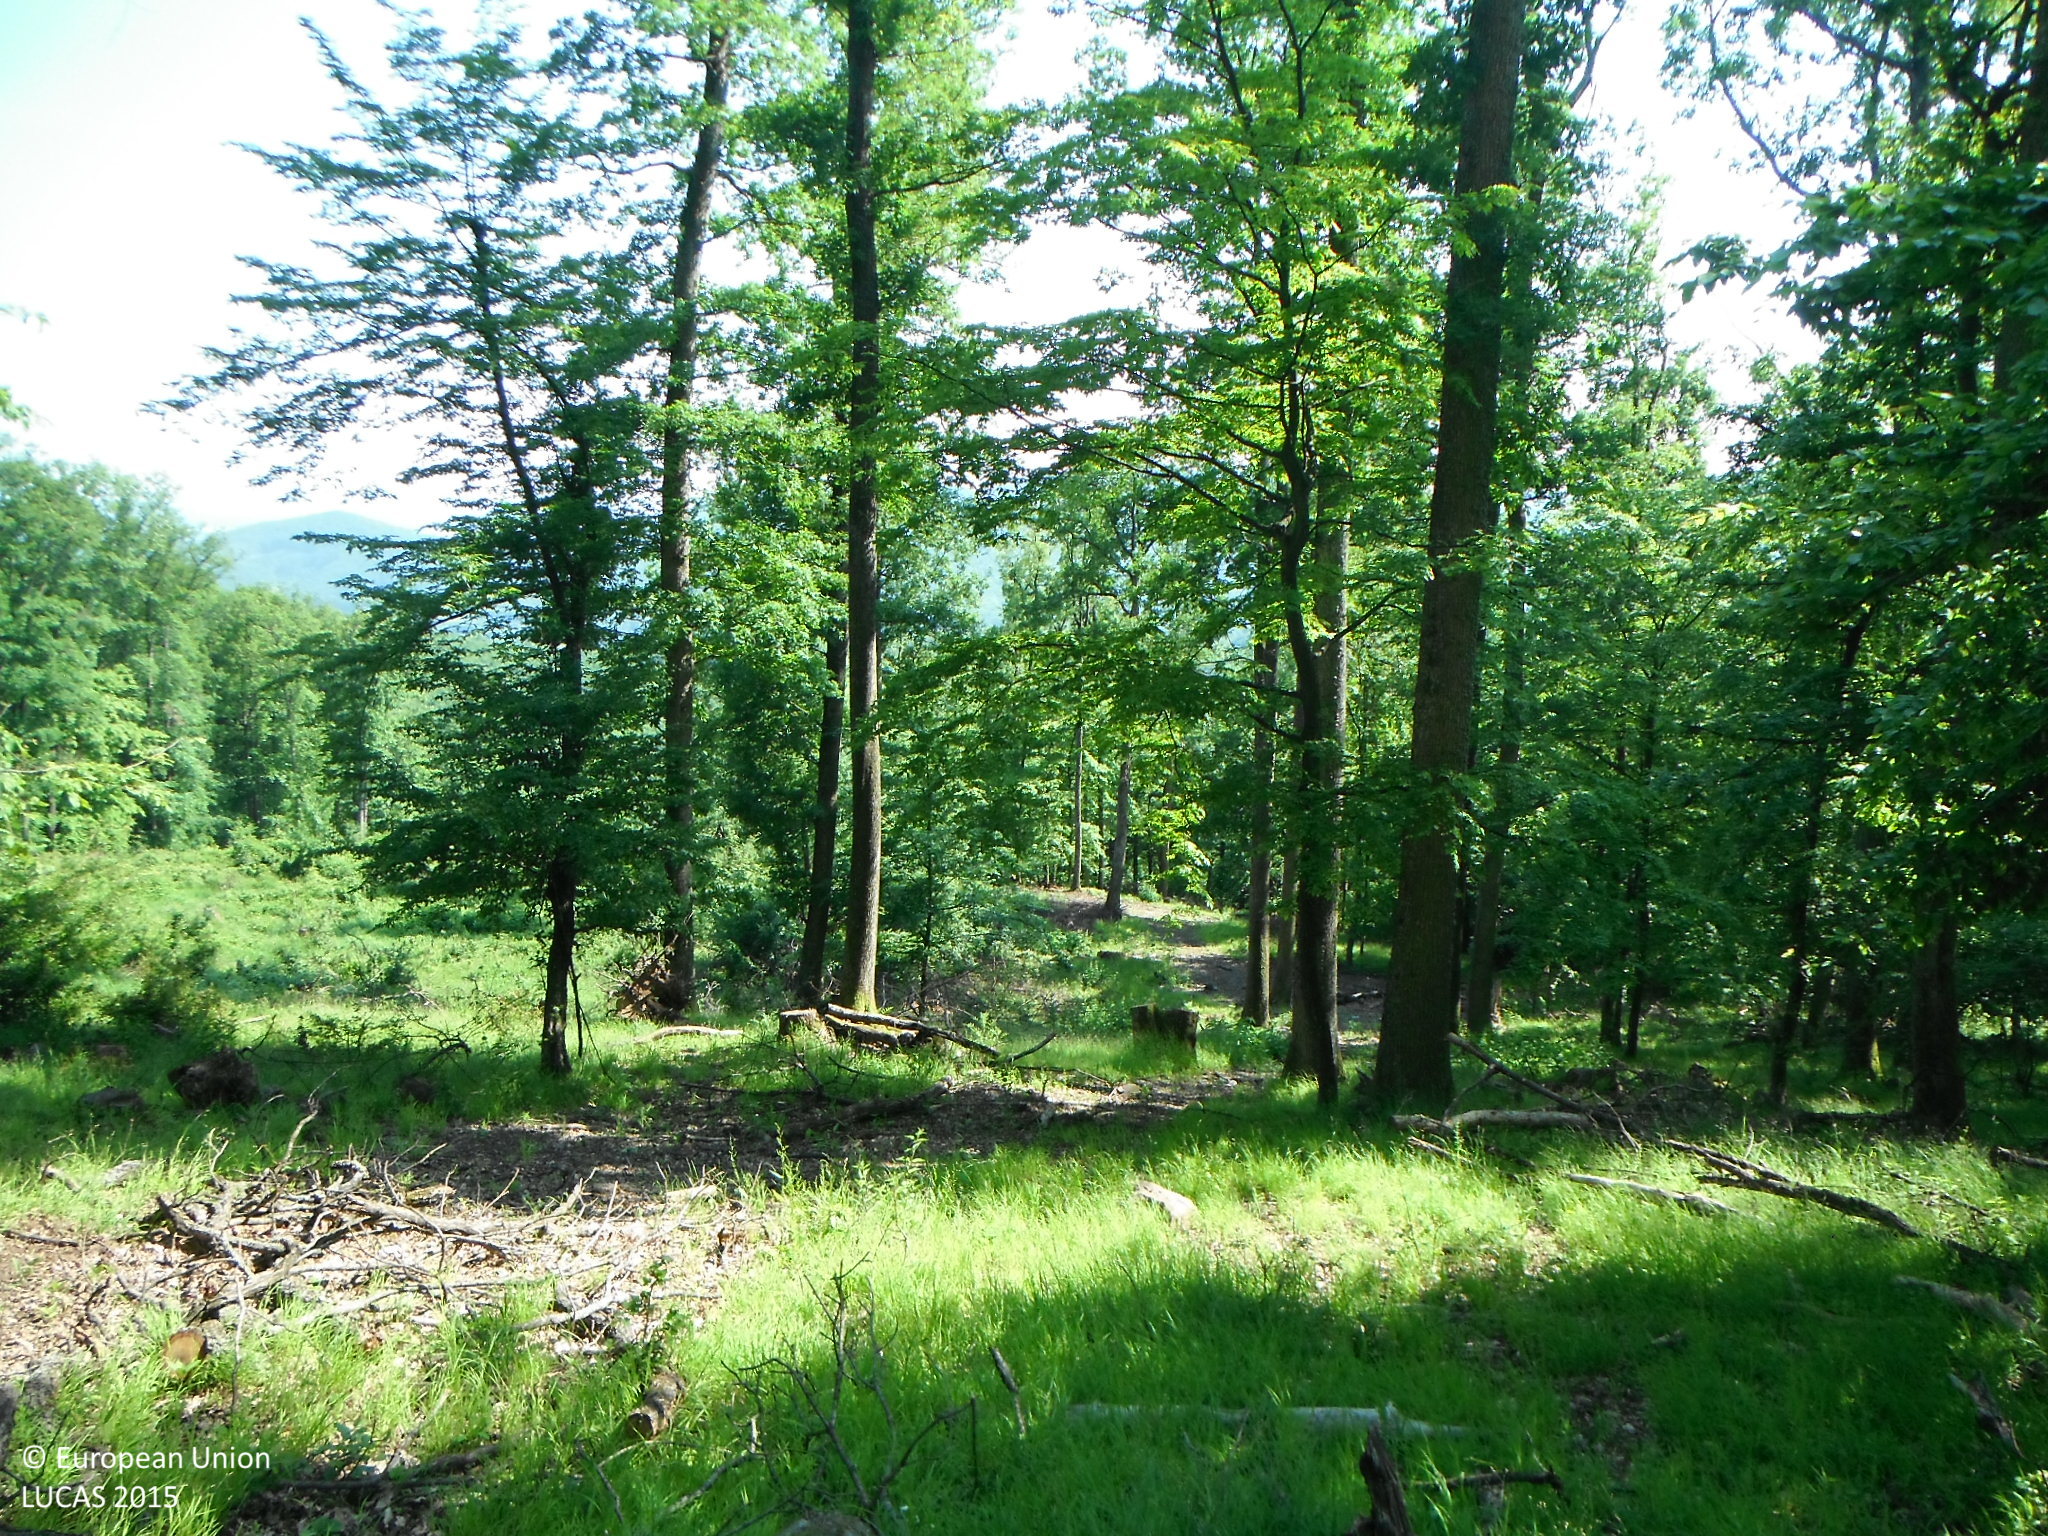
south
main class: Woodland
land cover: Broadleaved woodland
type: mesophytic deciduous forest
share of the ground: 50 - 75 %
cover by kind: broadleaved forest trees 75 %, herbaceous plants 25 %
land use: Forestry
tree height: > 5 m
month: May
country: SK
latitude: 48.3664
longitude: 18.9422
